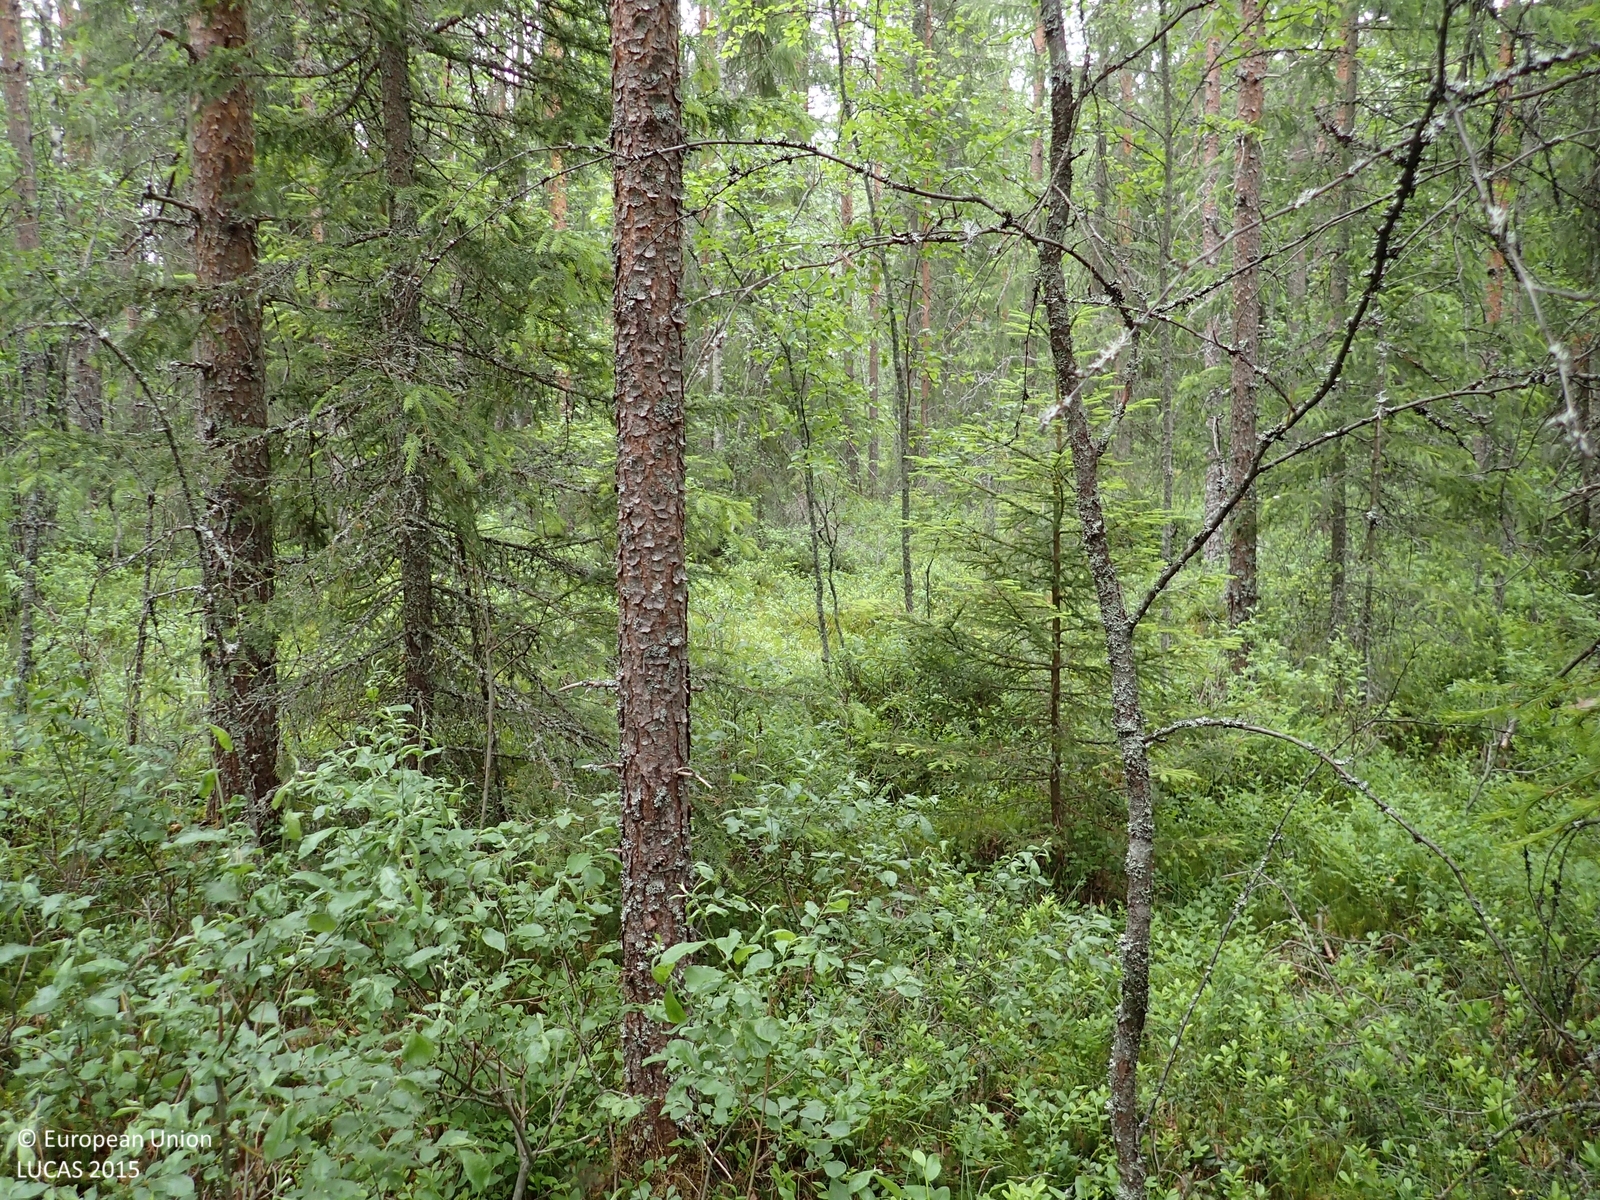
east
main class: Woodland
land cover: Pine dominated coniferous woodland
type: mire and swamp forests
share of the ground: > 75 %
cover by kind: coniferous forest trees 70 %, shrubs 20 %, broadleaved forest trees 5 %, lichens and mosses 5 %
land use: Forestry
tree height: > 5 m
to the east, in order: Pine dominated coniferous woodland; Ditches and canals; Pine dominated coniferous woodland; Ditches and canals; Pine dominated coniferous woodland
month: July
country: FI
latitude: 62.7194
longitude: 21.4819
